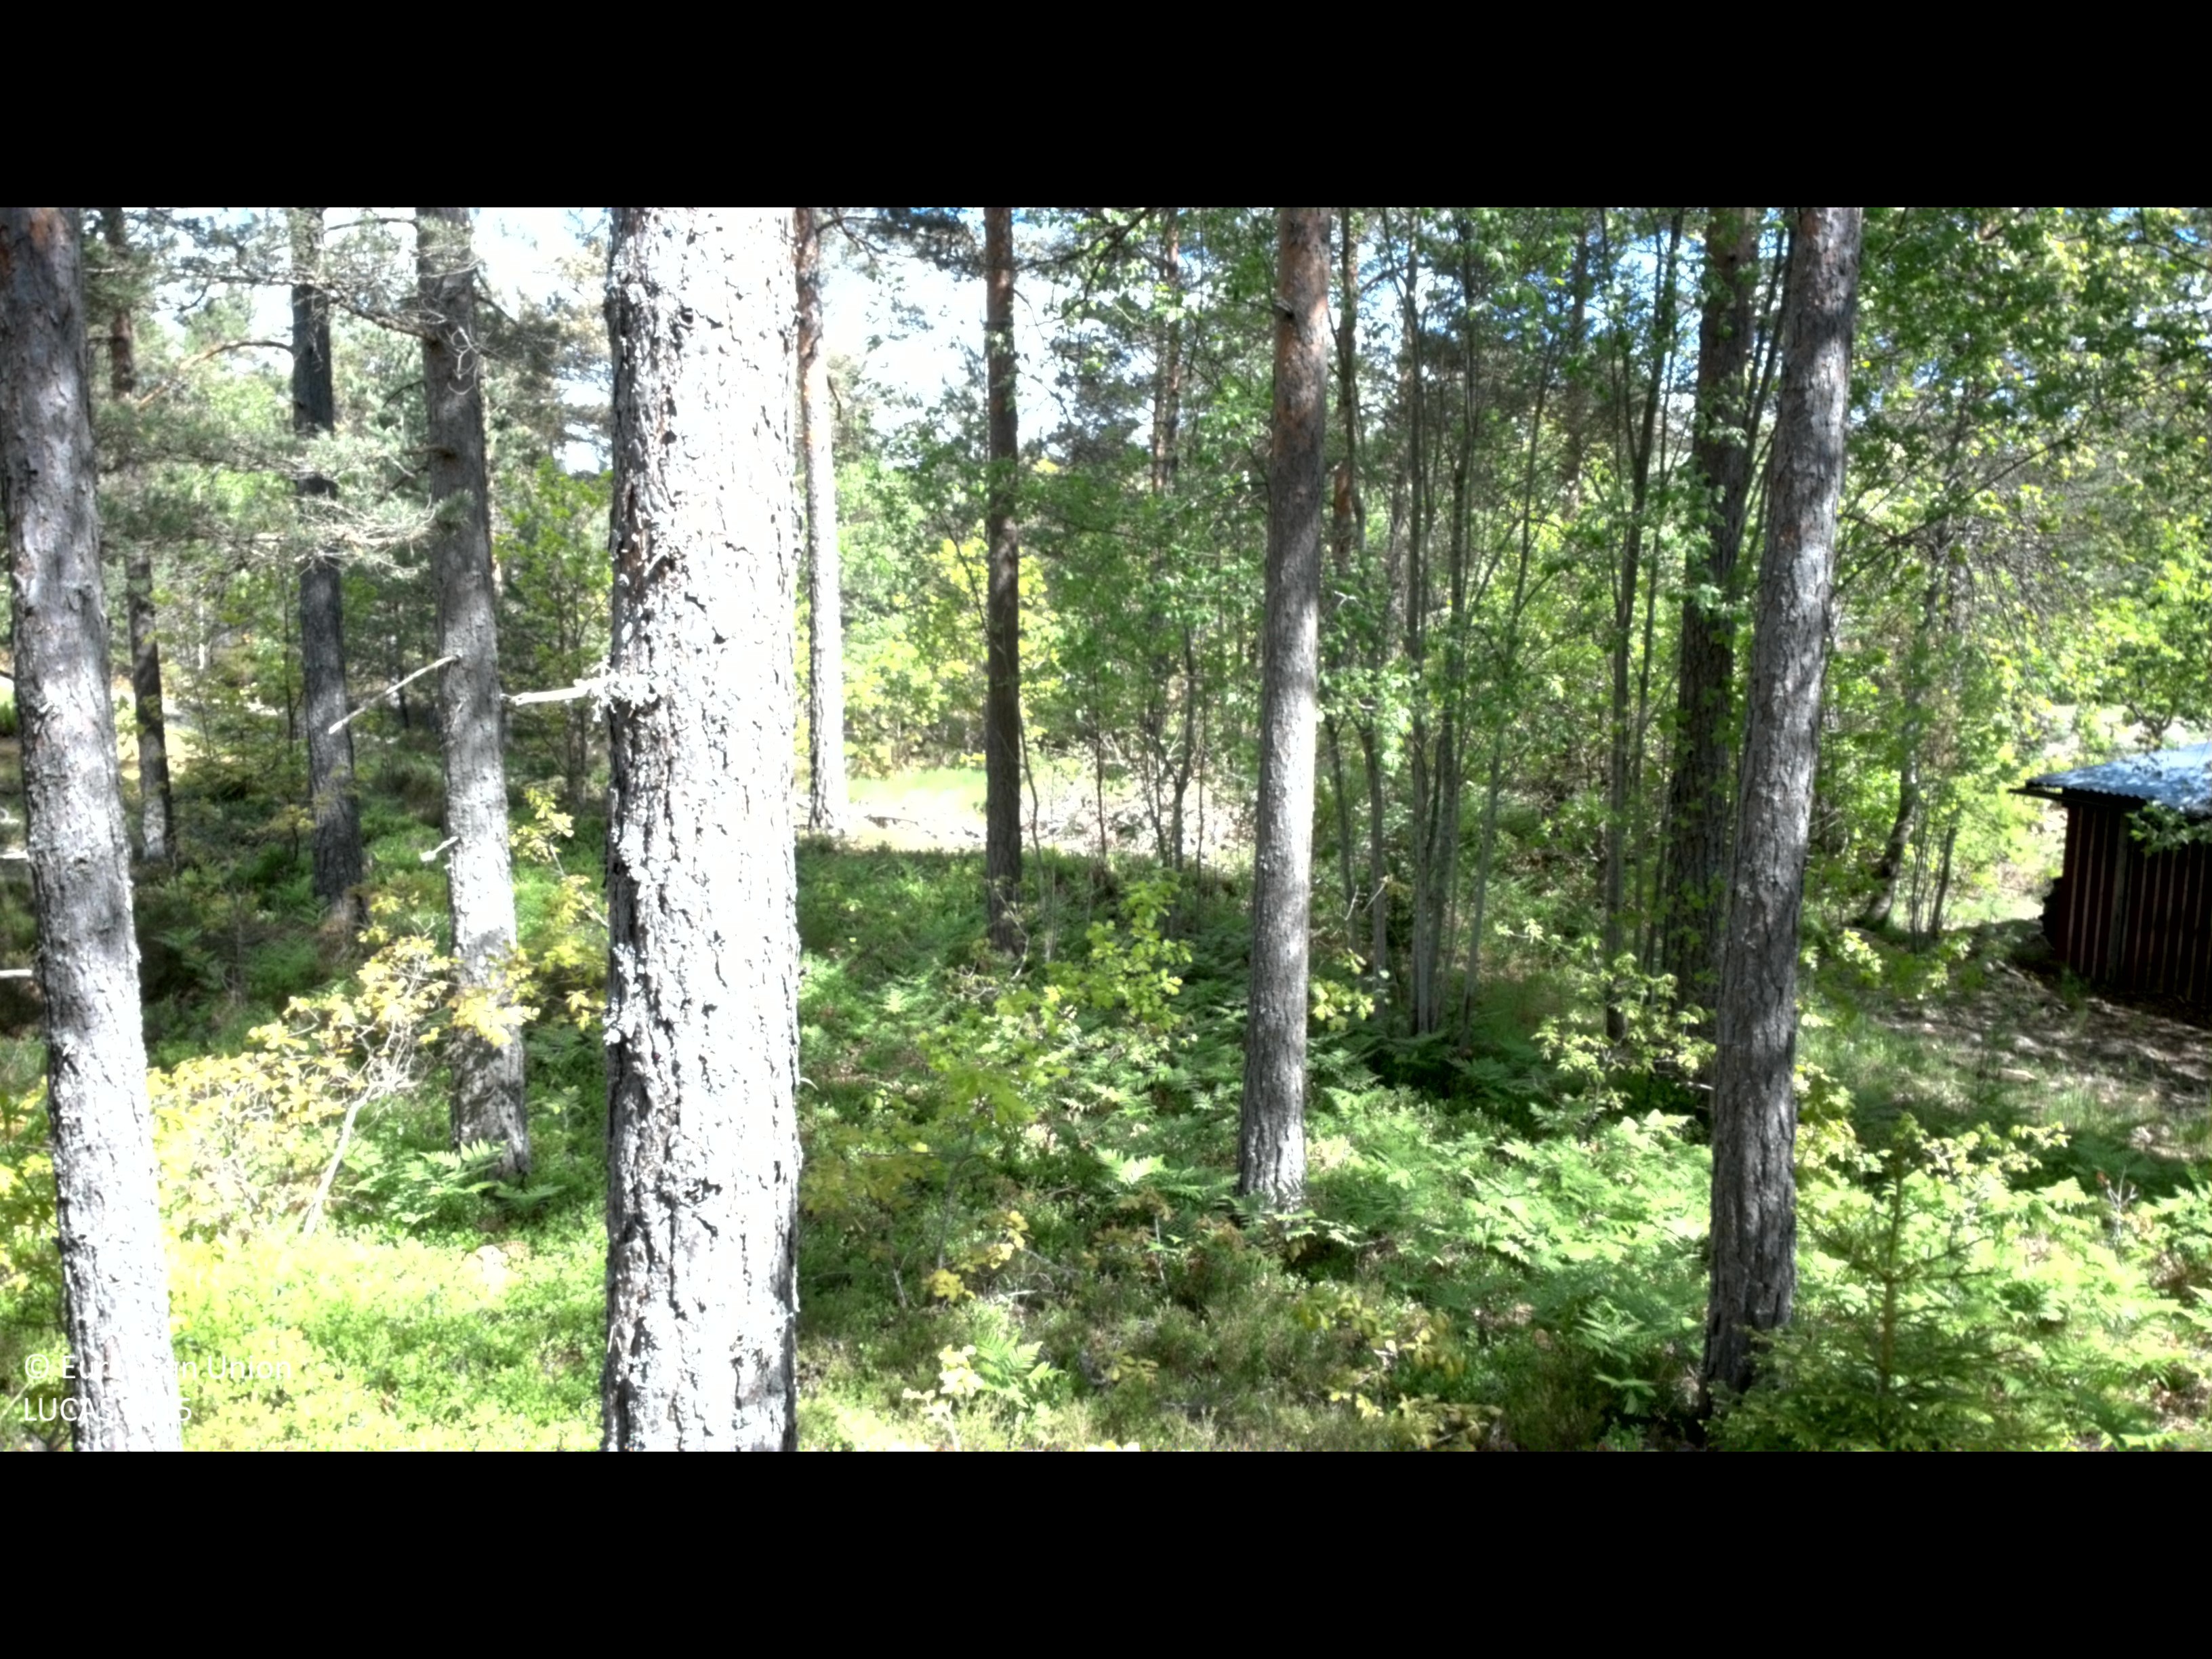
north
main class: Woodland
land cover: Pine dominated coniferous woodland
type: boreal forest
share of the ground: 50 - 75 %
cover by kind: coniferous forest trees 65 %, shrubs 15 %, lichens and mosses 15 %, broadleaved forest trees 5 %
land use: Forestry
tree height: > 5 m
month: May
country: SE
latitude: 57.5340
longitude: 16.5970
